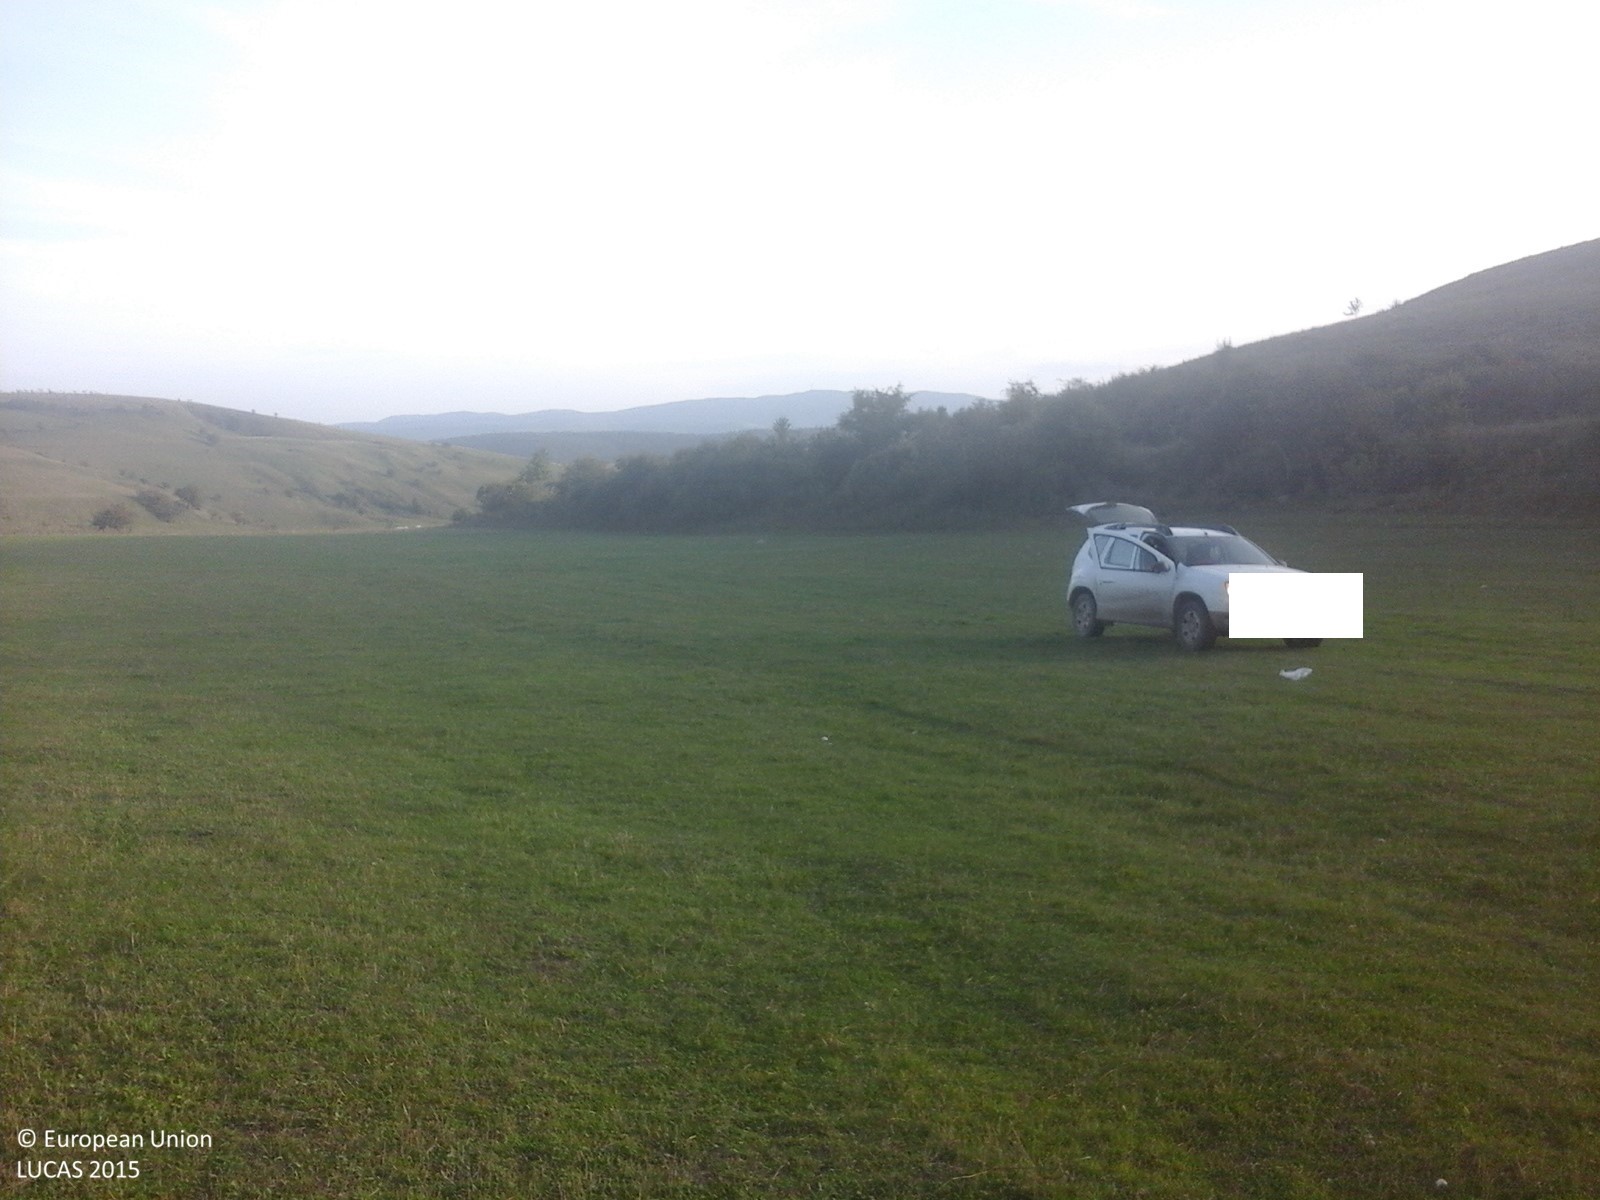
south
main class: Grassland
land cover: Grassland without tree/shrub cover
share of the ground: > 75 %
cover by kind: herbaceous plants 100 %
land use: Agriculture (excluding fallow land and kitchen gardens)
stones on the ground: < 10 %
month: September
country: RO
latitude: 46.7854
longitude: 23.3624
